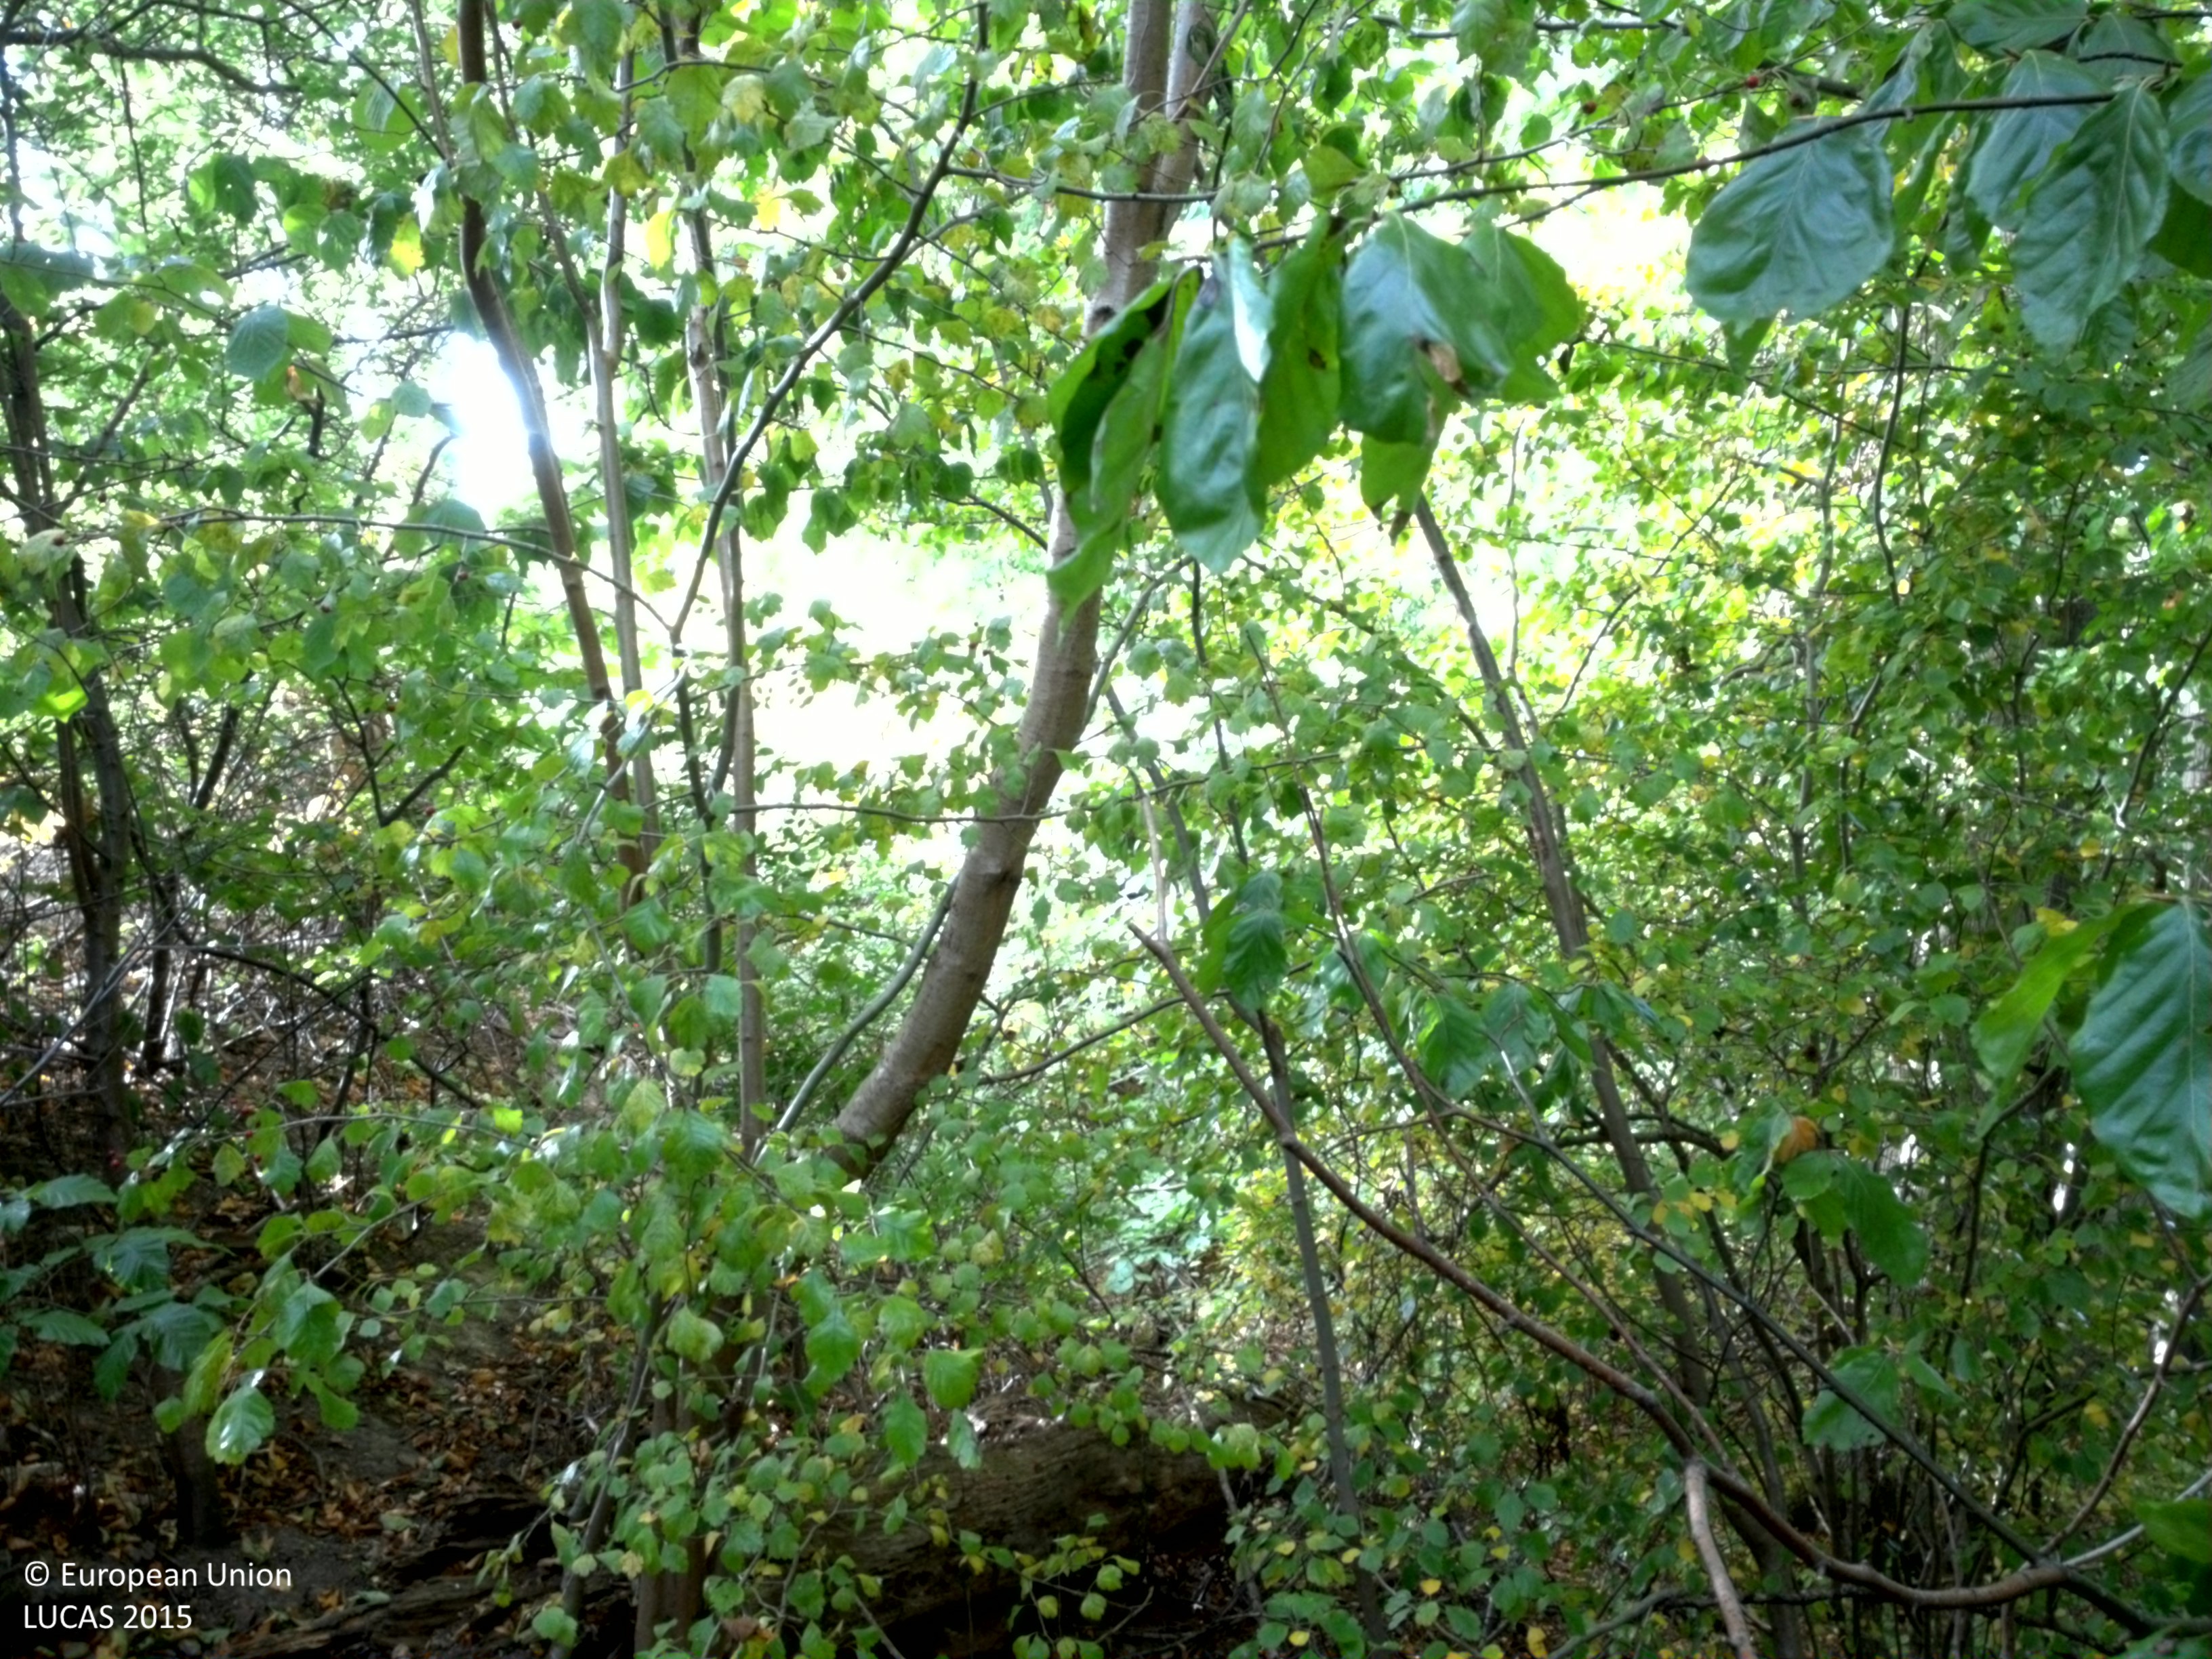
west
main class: Woodland
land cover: Broadleaved woodland
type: beech forest
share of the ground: > 75 %
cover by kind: broadleaved forest trees 85 %, unconsolidated bare surface 10 %, shrubs 5 %
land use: Forestry
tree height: > 5 m
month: October
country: SE
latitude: 55.6307
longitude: 14.2712
